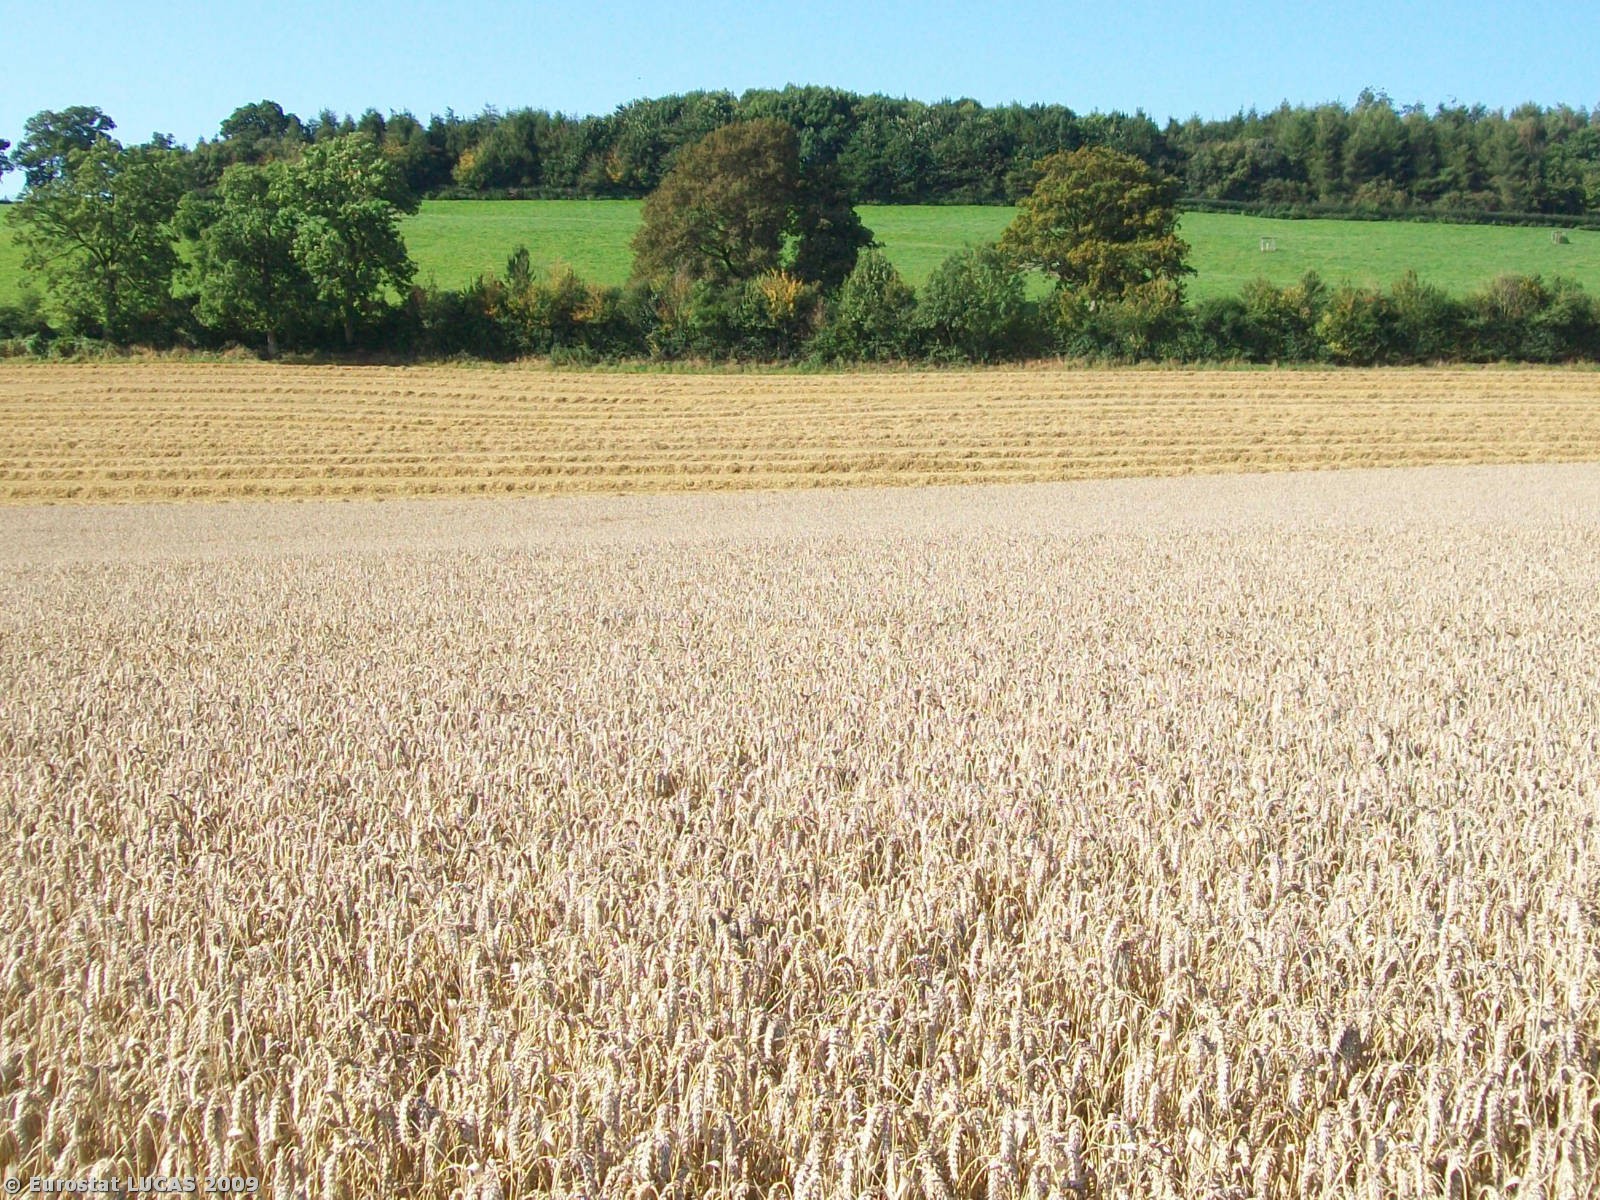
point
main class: Cropland
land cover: Common wheat
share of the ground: > 75 %
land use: Agriculture (excluding fallow land and kitchen gardens)
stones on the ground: < 10 %
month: September
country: GB
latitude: 52.2383
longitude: -2.5288
